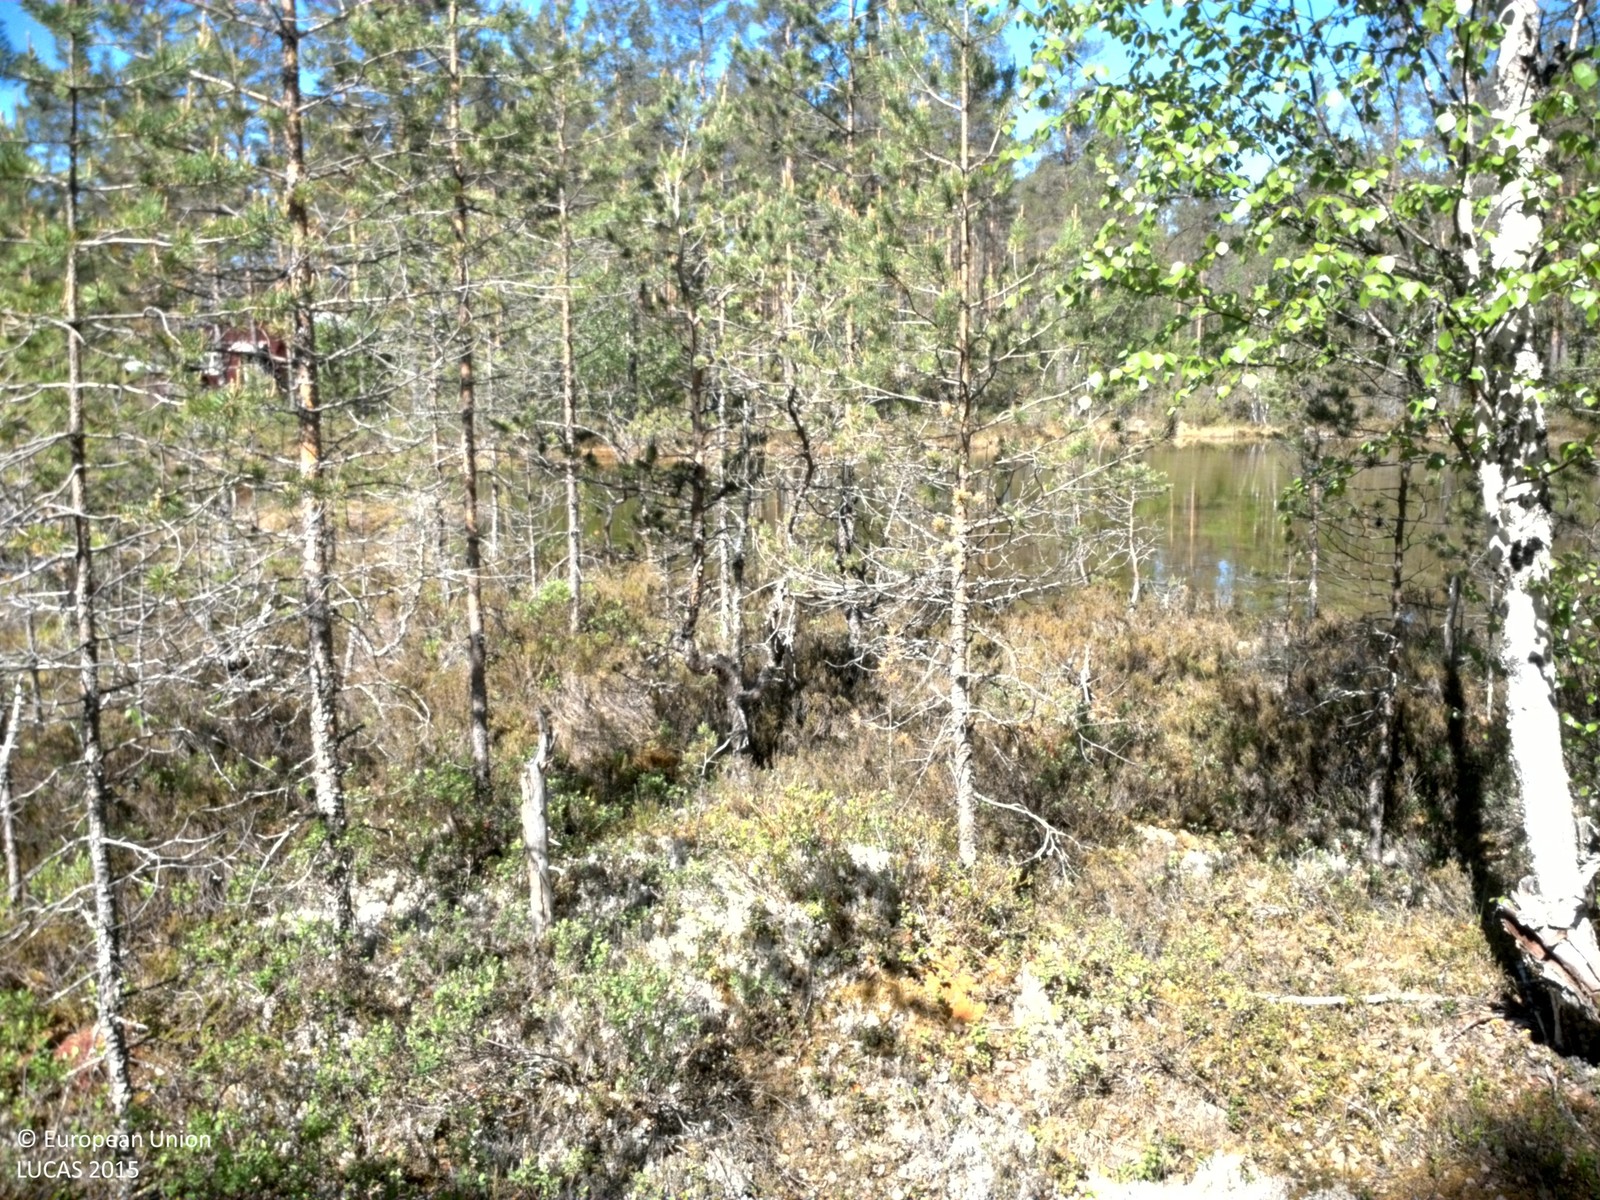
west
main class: Woodland
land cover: Pine dominated coniferous woodland
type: boreal forest
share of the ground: 50 - 75 %
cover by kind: coniferous forest trees 50 %, broadleaved forest trees 15 %, shrubs 15 %, herbaceous plants 15 %, lichens and mosses 5 %
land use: Forestry
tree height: < 5 m
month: June
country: SE
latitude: 61.3228
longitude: 13.6674
